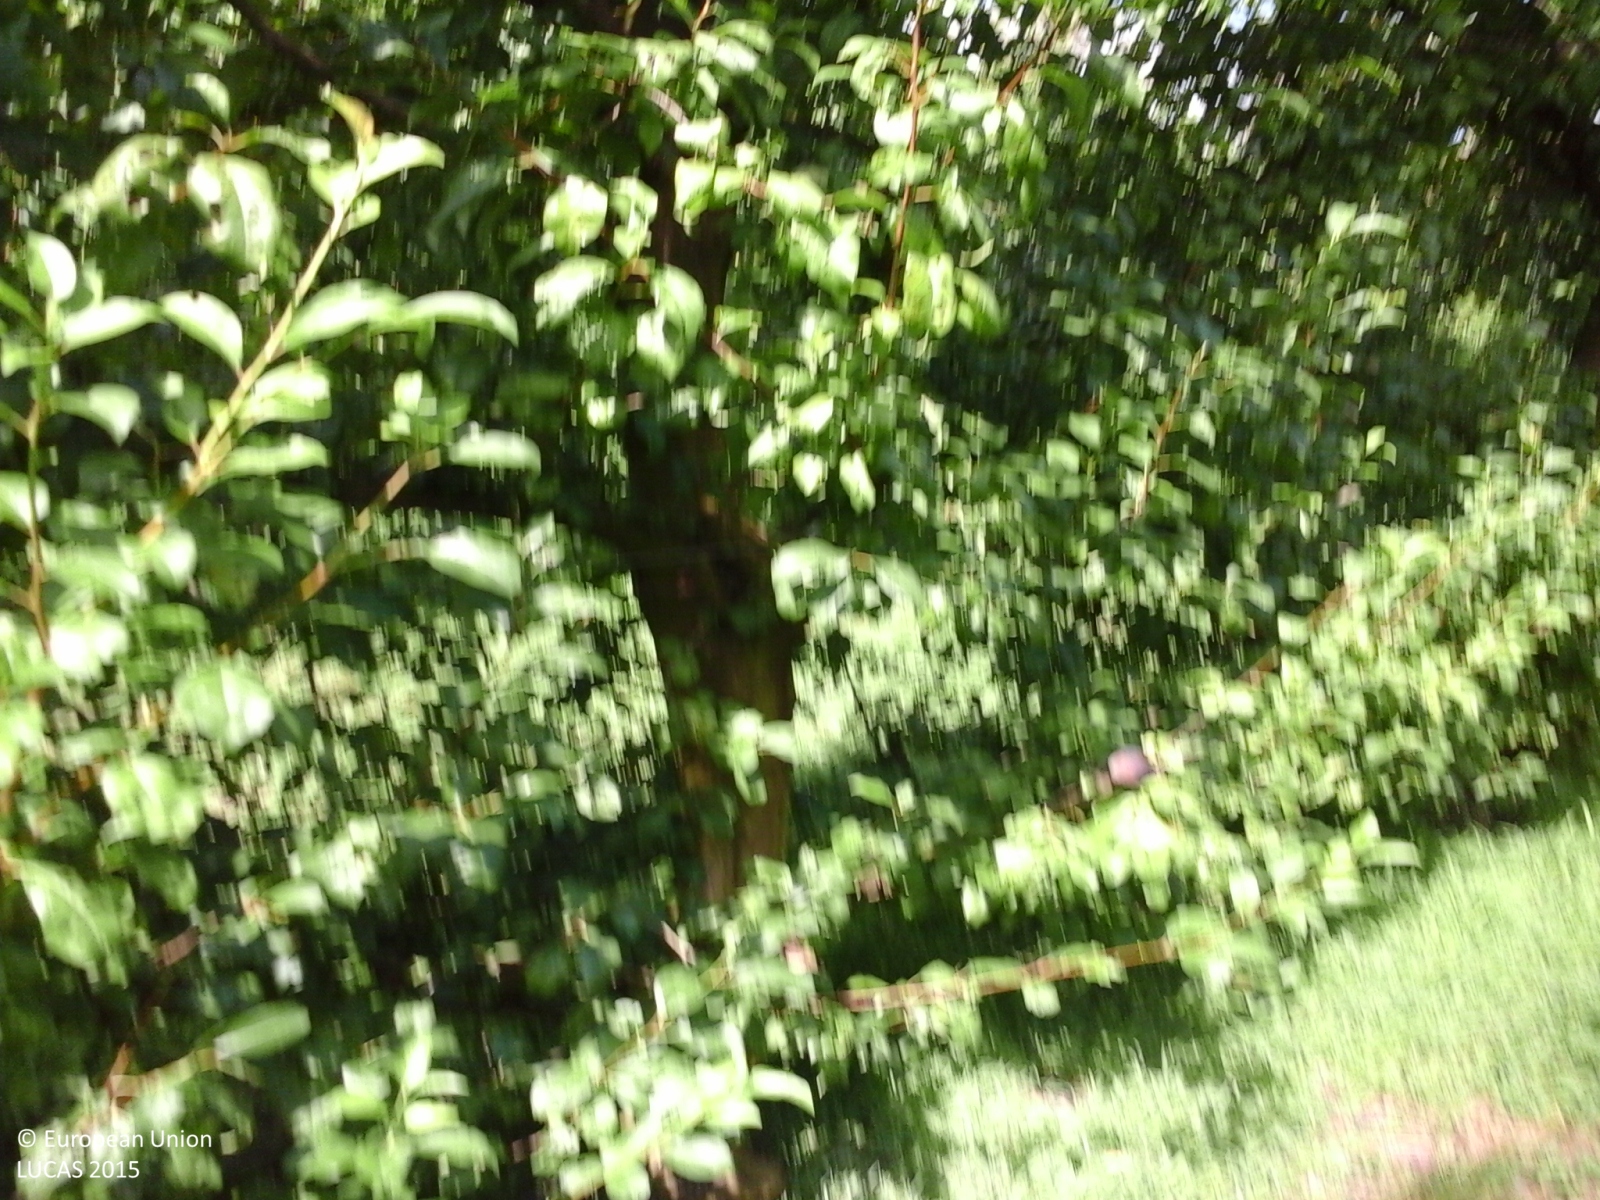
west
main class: Cropland
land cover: Other fruit trees and berries
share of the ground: 25 - 50 %
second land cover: Spontaneously vegetated surfaces
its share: > 75 %
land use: Agriculture (excluding fallow land and kitchen gardens)
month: July
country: IT
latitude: 41.4916
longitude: 12.8991
